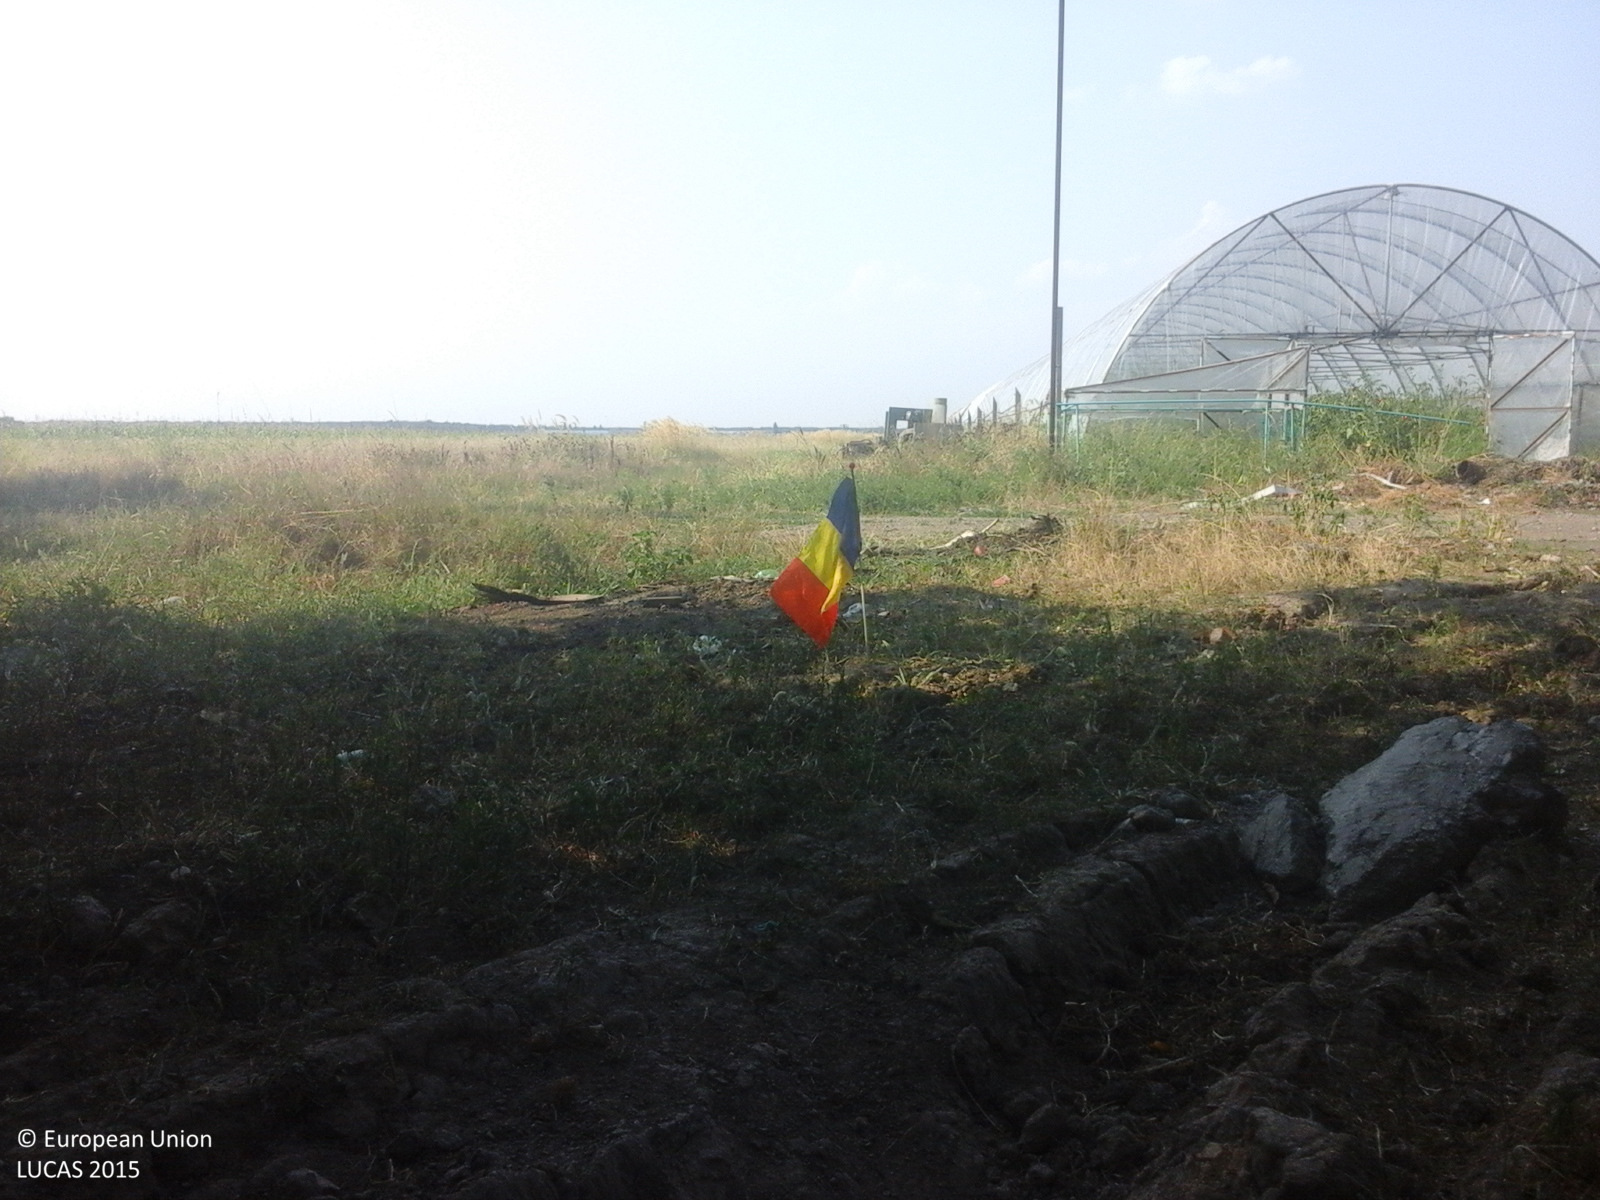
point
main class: Woodland
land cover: Broadleaved woodland
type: acidophilous oak and oak-birch forest
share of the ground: > 75 %
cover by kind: broadleaved forest trees 100 %
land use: Forestry
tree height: > 5 m
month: August
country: RO
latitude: 44.2743
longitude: 23.7240
